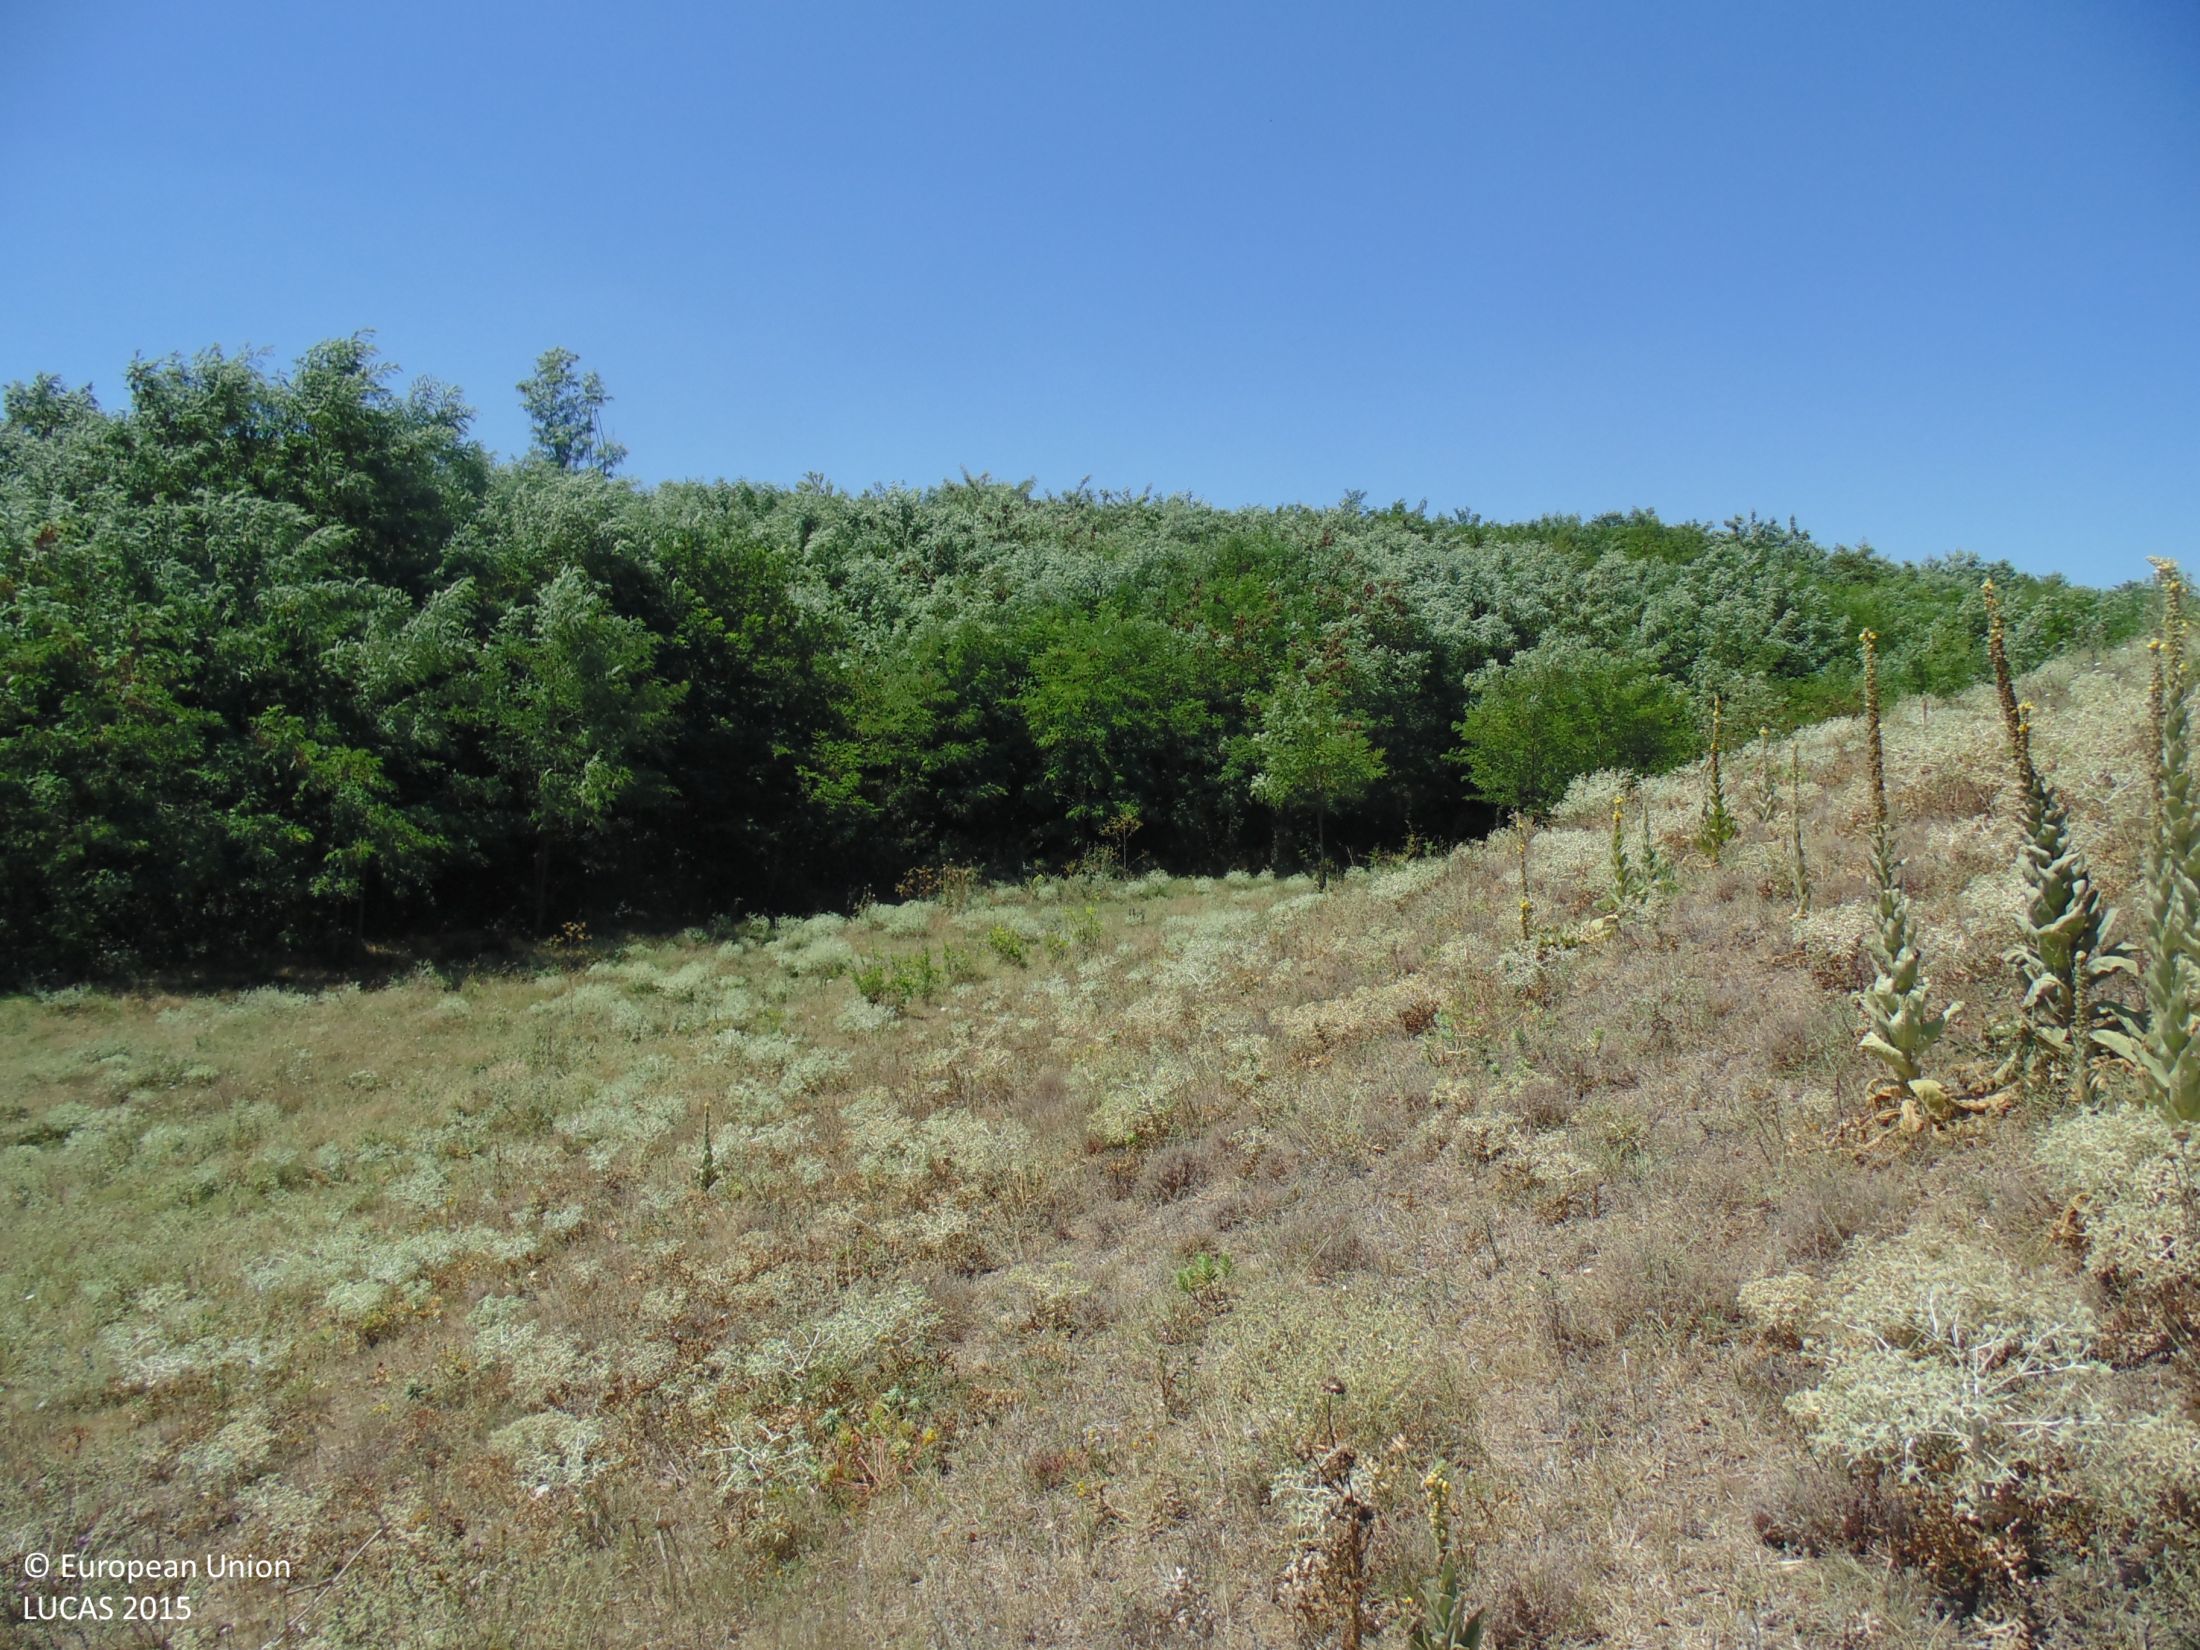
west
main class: Grassland
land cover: Grassland with sparse tree/shrub cover
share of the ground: > 75 %
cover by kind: herbaceous plants 90 %, broadleaved forest trees 5 %, shrubs 5 %
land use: Agriculture (excluding fallow land and kitchen gardens)
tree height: < 5 m
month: July
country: BG
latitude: 43.6908
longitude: 27.7455
